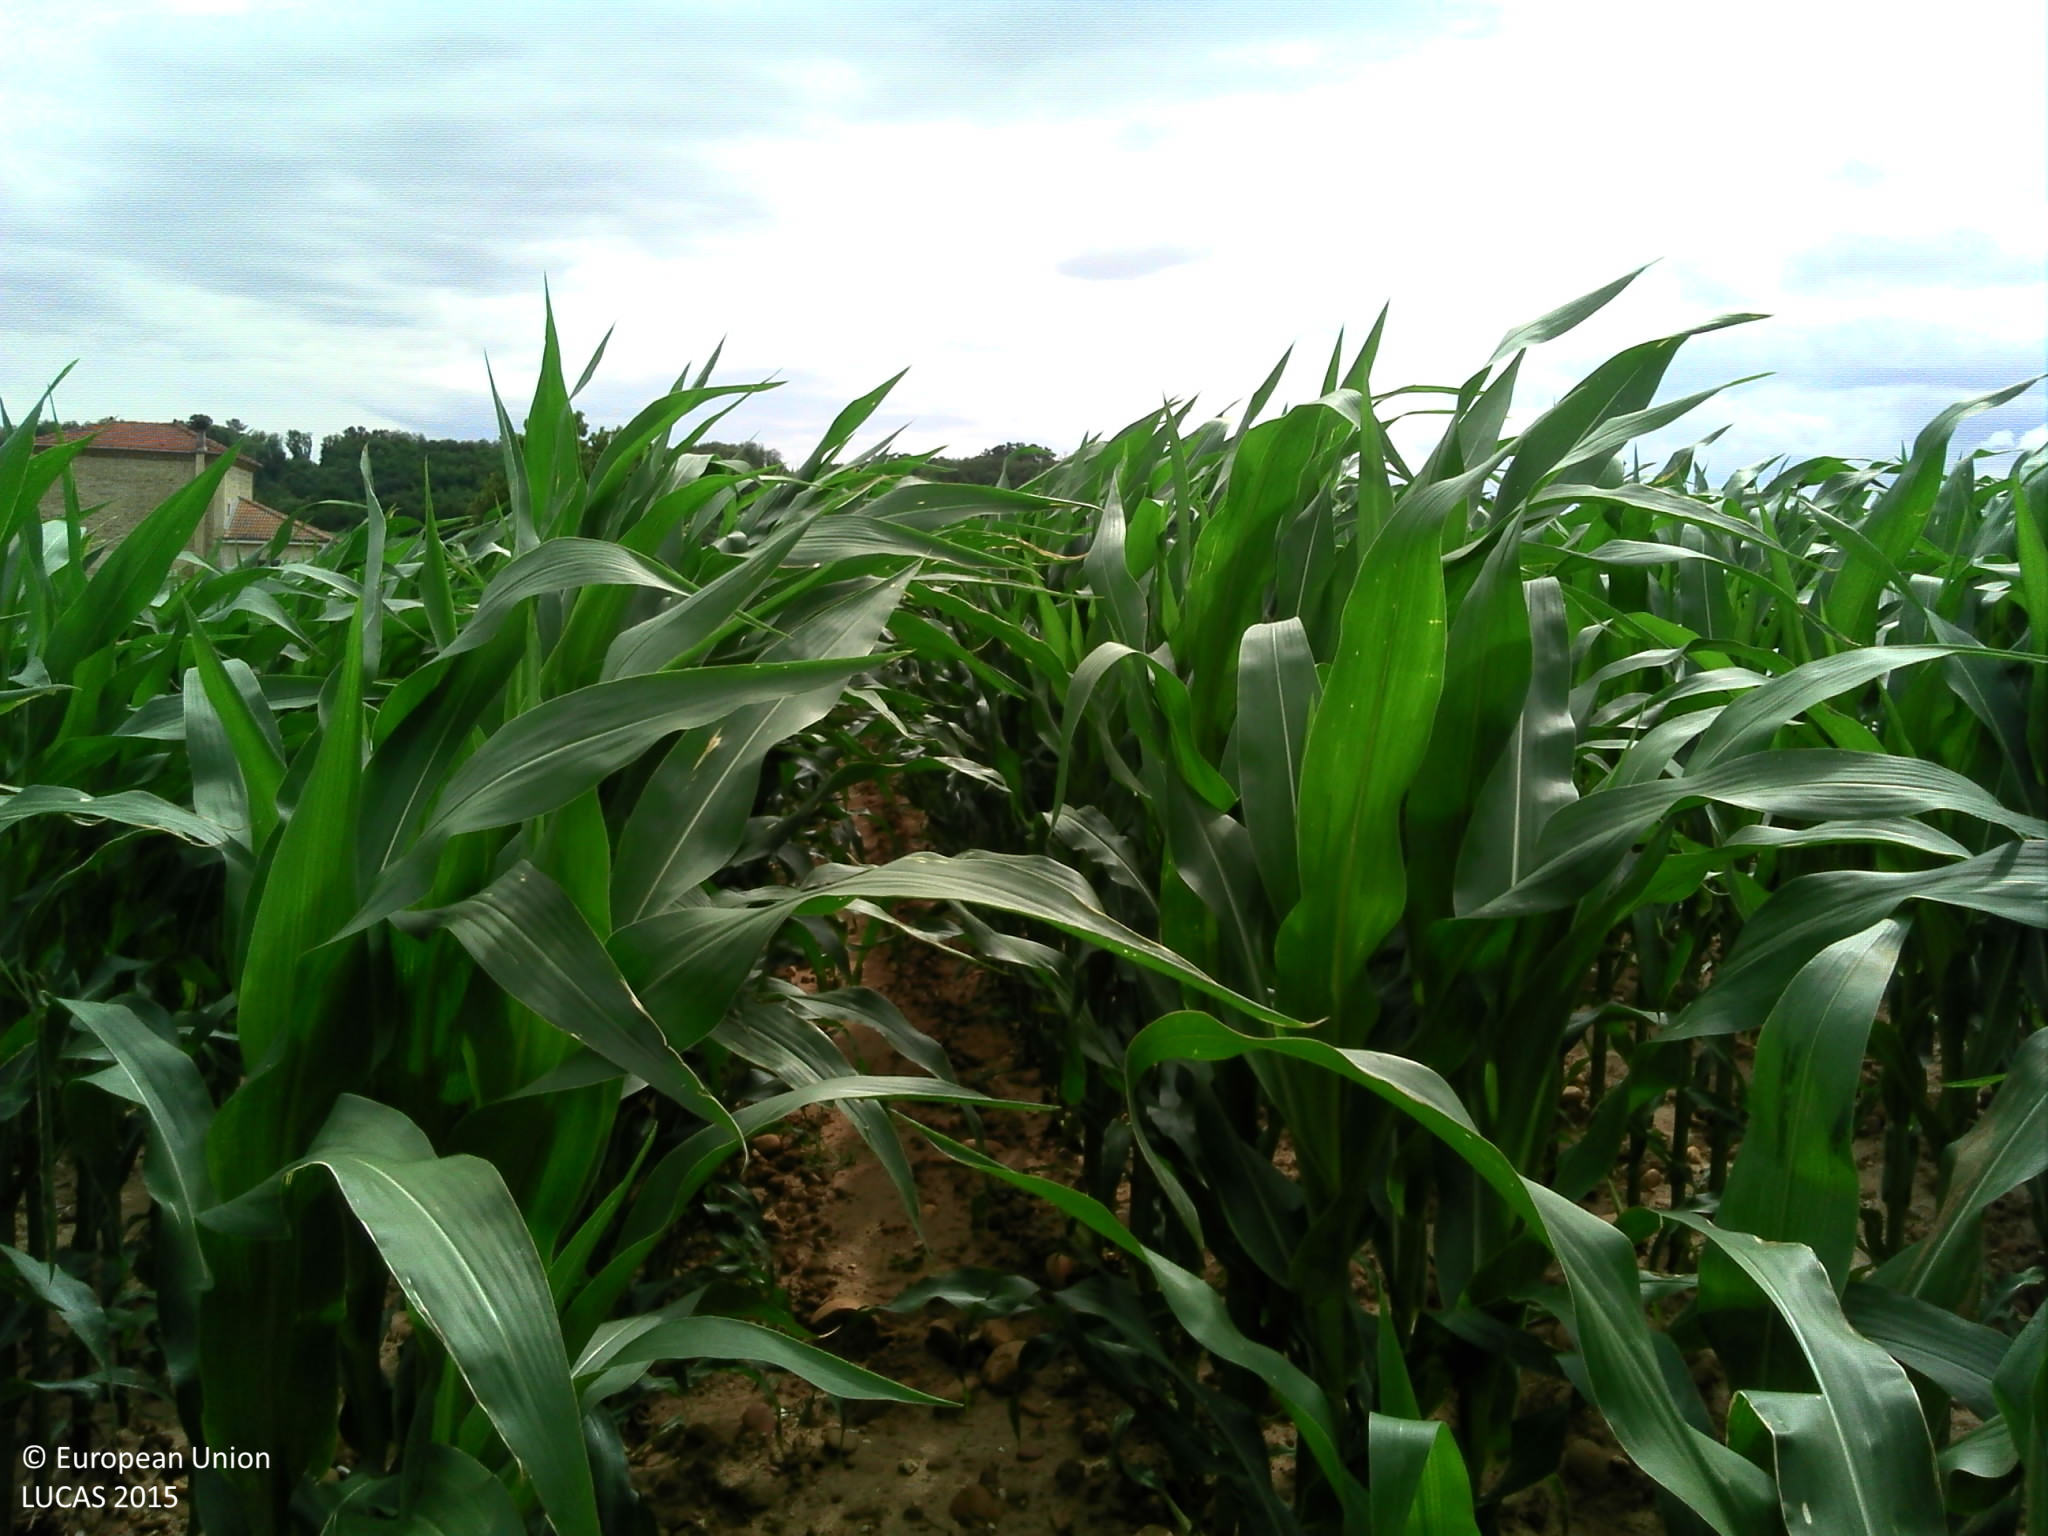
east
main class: Cropland
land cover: Maize
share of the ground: > 75 %
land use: Agriculture (excluding fallow land and kitchen gardens)
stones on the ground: 25 - 50 %
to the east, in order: Maize; Grass margins; Electric lines; Paved roads, cycling and walking lanes; Grass margins; Common wheat
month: June
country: FR
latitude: 45.1647
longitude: 4.9035
